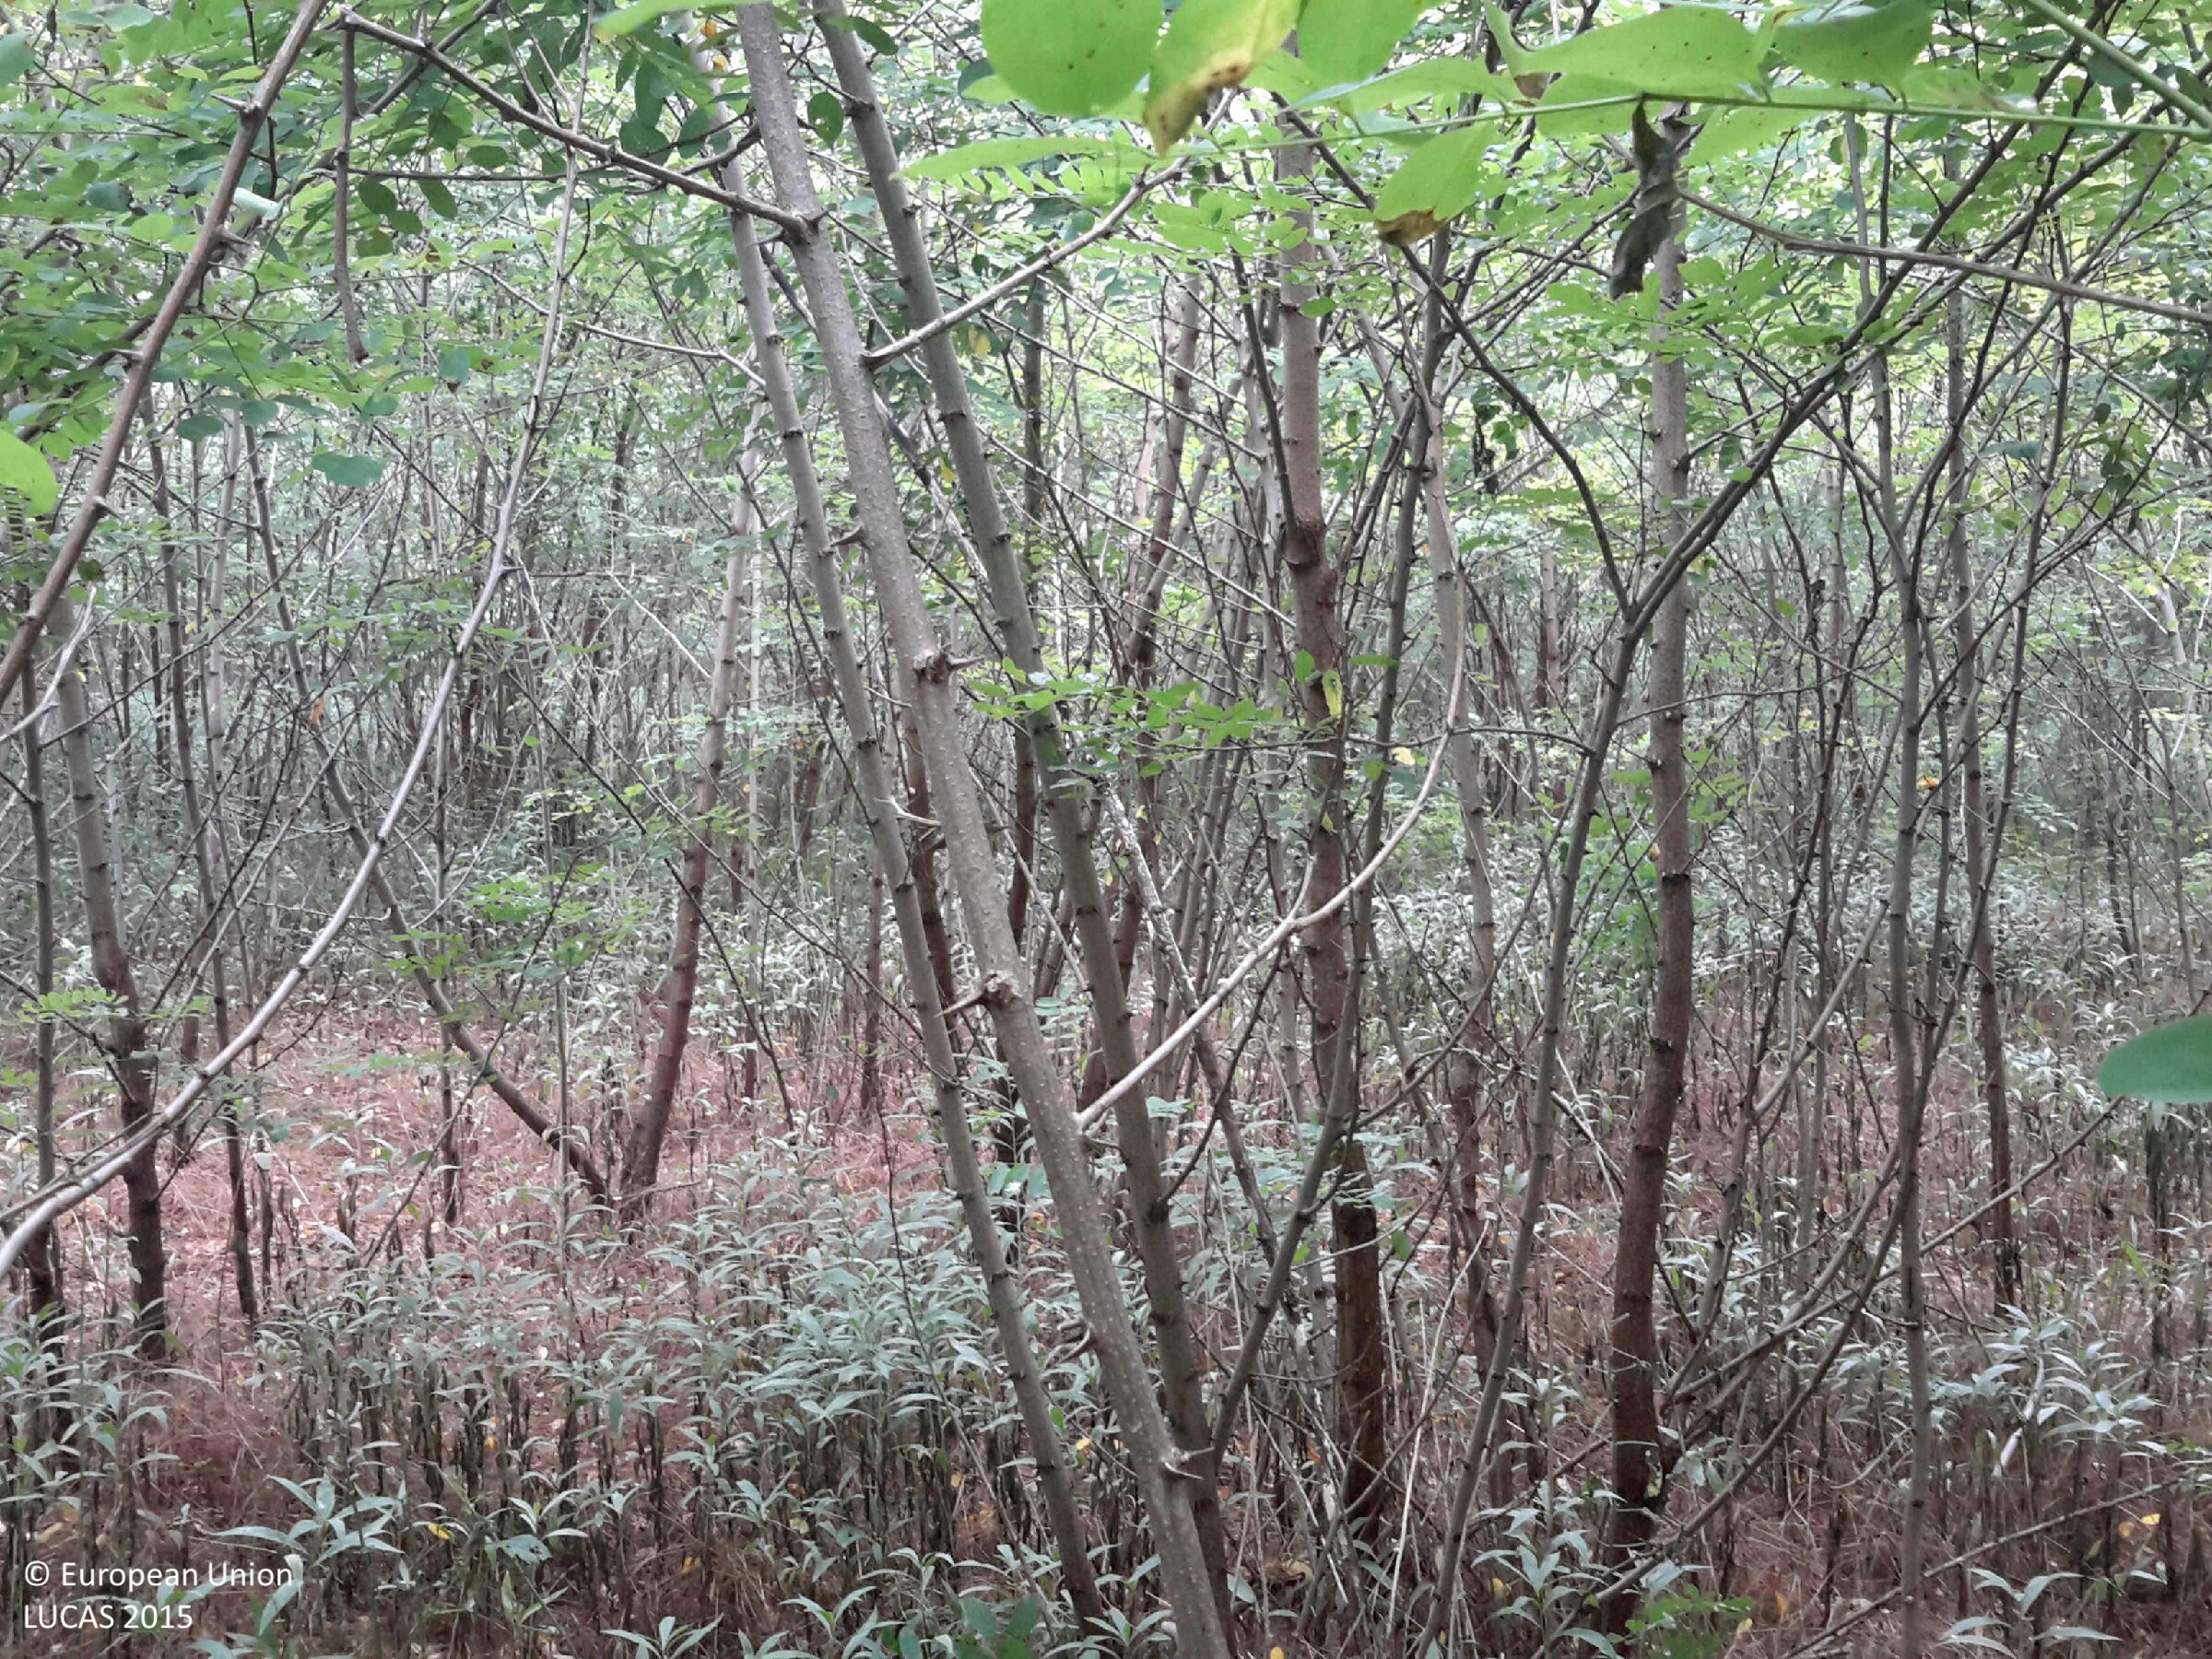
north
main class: Woodland
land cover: Broadleaved woodland
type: exotic forest
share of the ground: > 75 %
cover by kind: broadleaved forest trees 60 %, shrubs 35 %, herbaceous plants 5 %
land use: Forestry
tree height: > 5 m
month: July
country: HU
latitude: 47.5529
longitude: 17.4896
